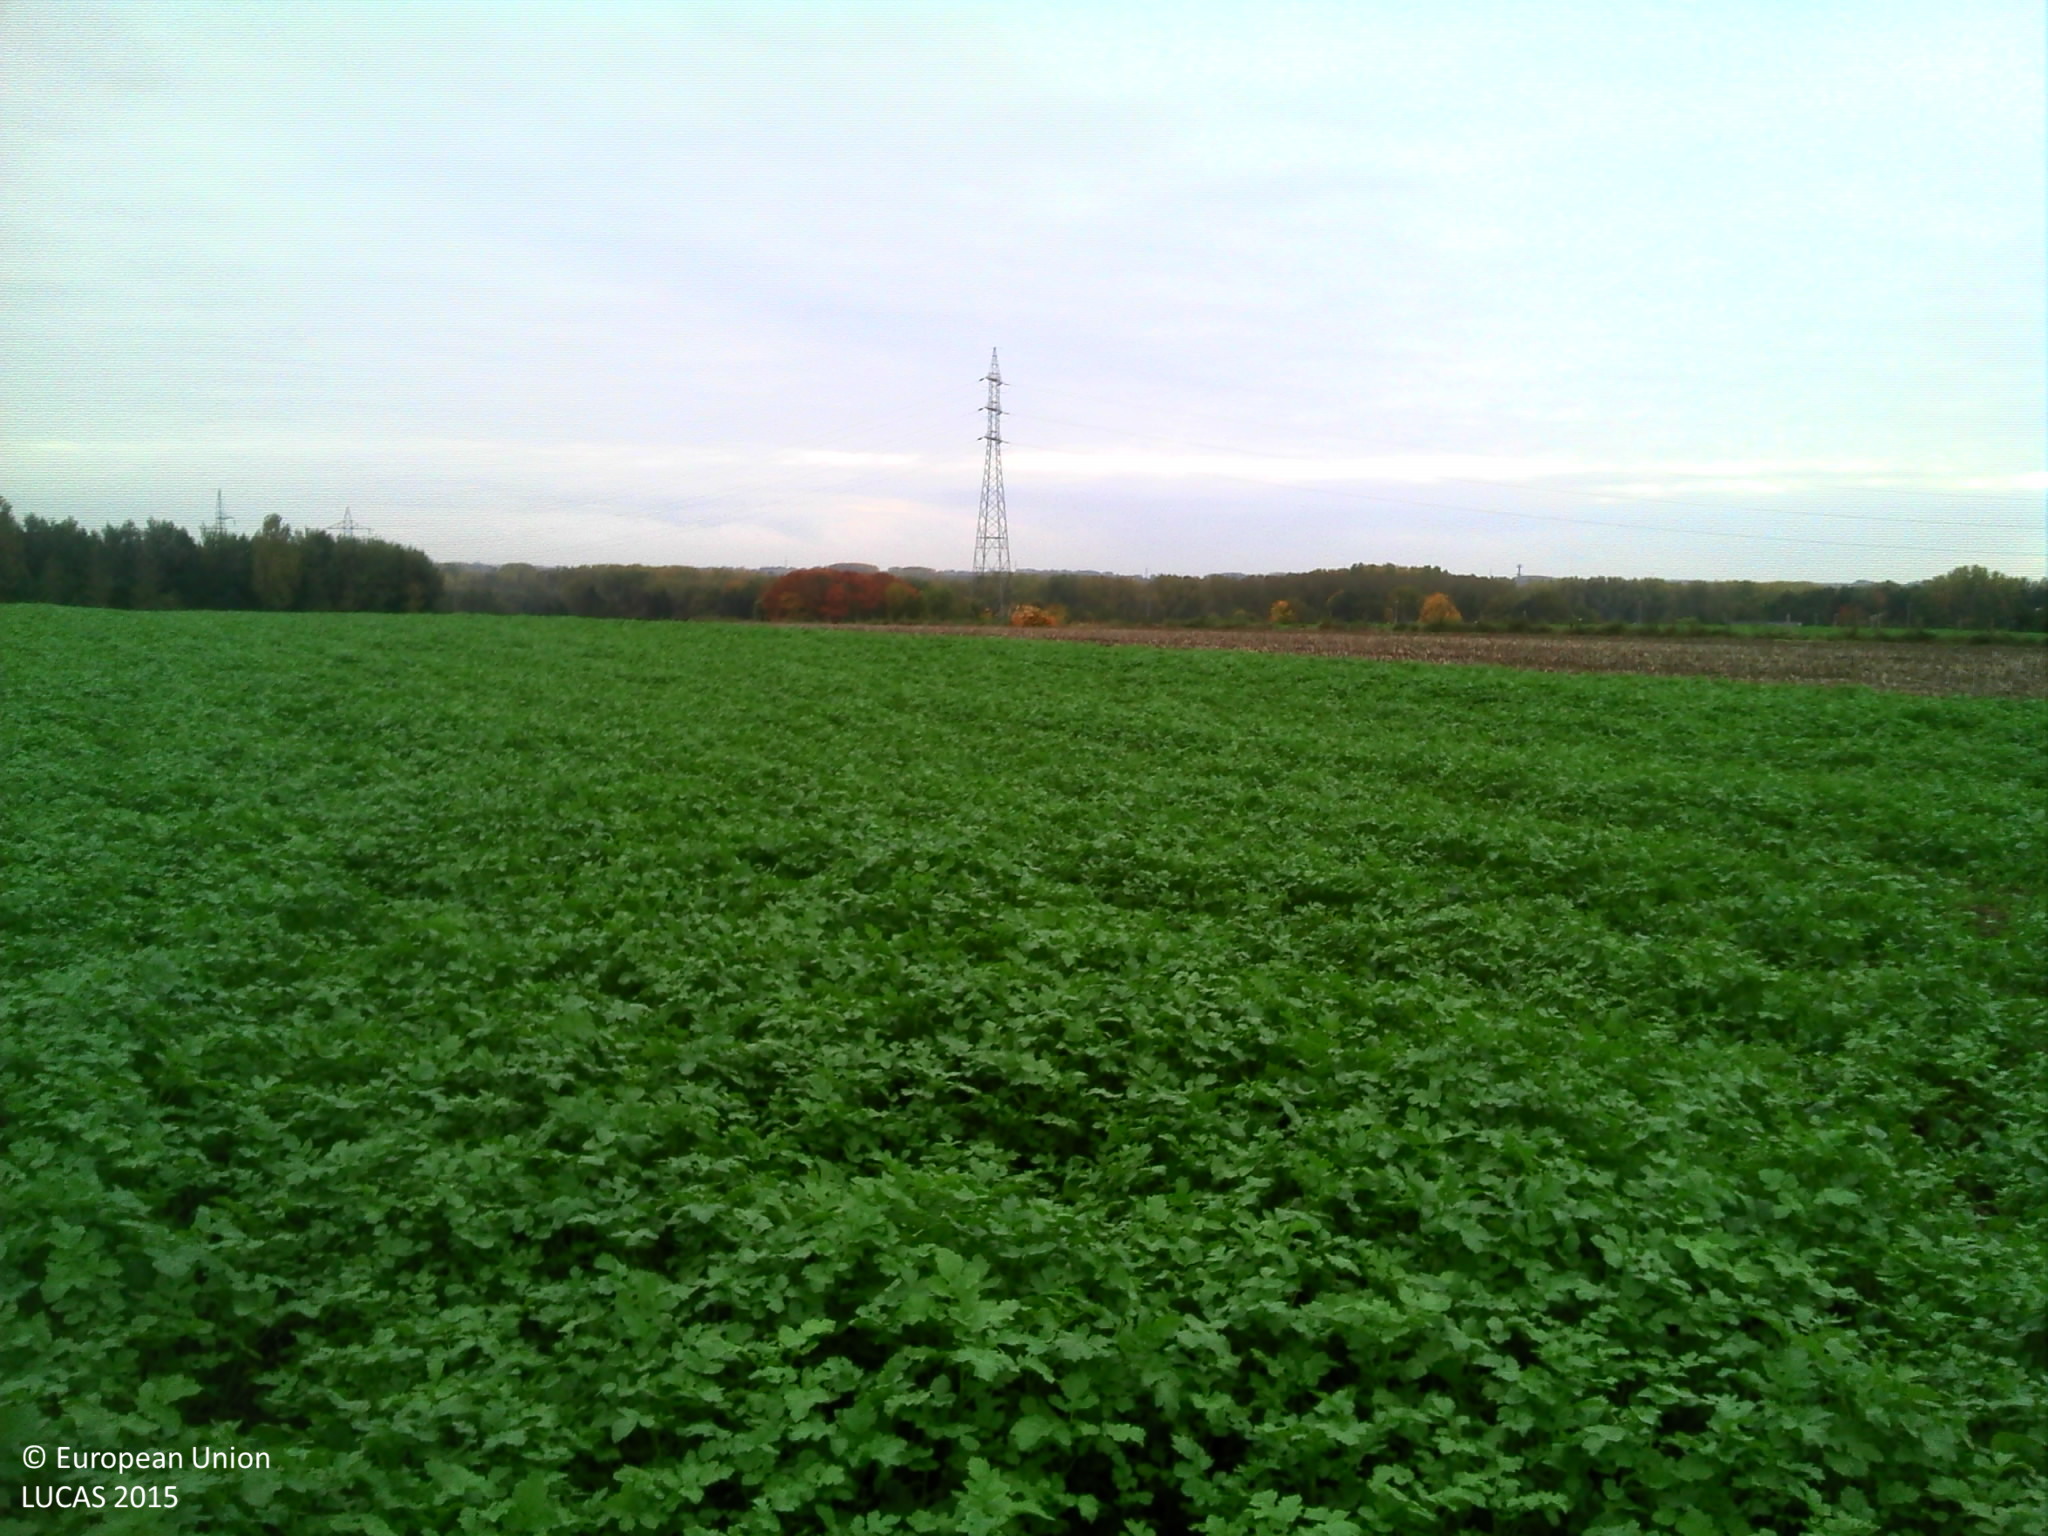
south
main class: Cropland
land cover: Other fibre and oleaginous crops
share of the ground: > 75 %
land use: Agriculture (excluding fallow land and kitchen gardens)
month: October
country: BE
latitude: 50.8980
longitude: 4.1223
